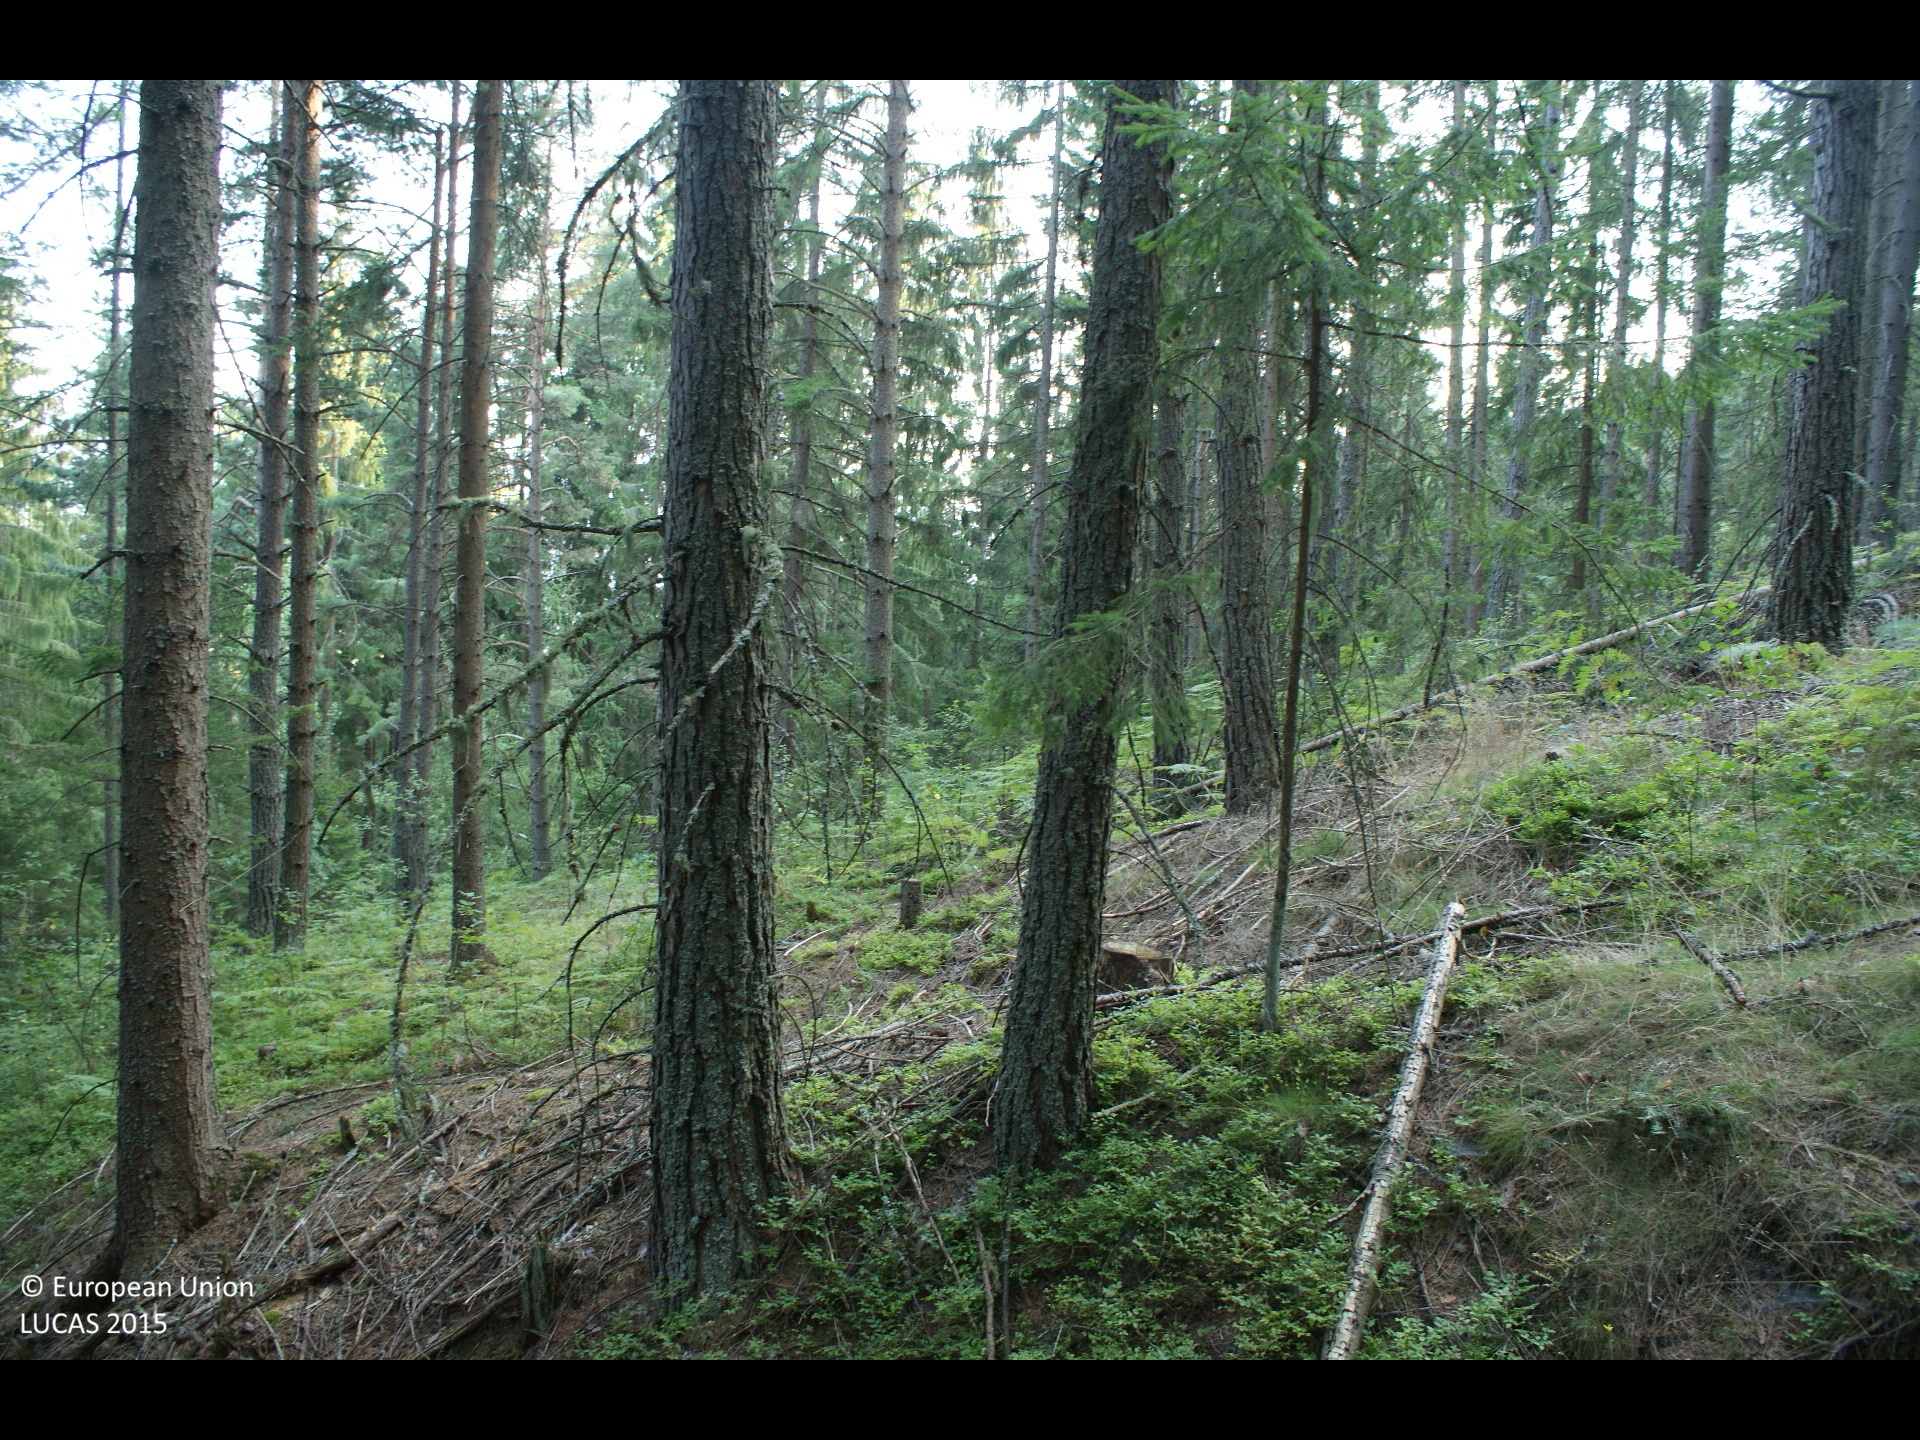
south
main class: Woodland
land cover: Spruce dominated coniferous woodland
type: alpine coniferous forest
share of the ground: > 75 %
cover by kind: coniferous forest trees 80 %, shrubs 10 %, herbaceous plants 5 %, unconsolidated bare surface 5 %
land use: Forestry
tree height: > 5 m
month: August
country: AT
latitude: 47.4972
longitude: 15.3768
